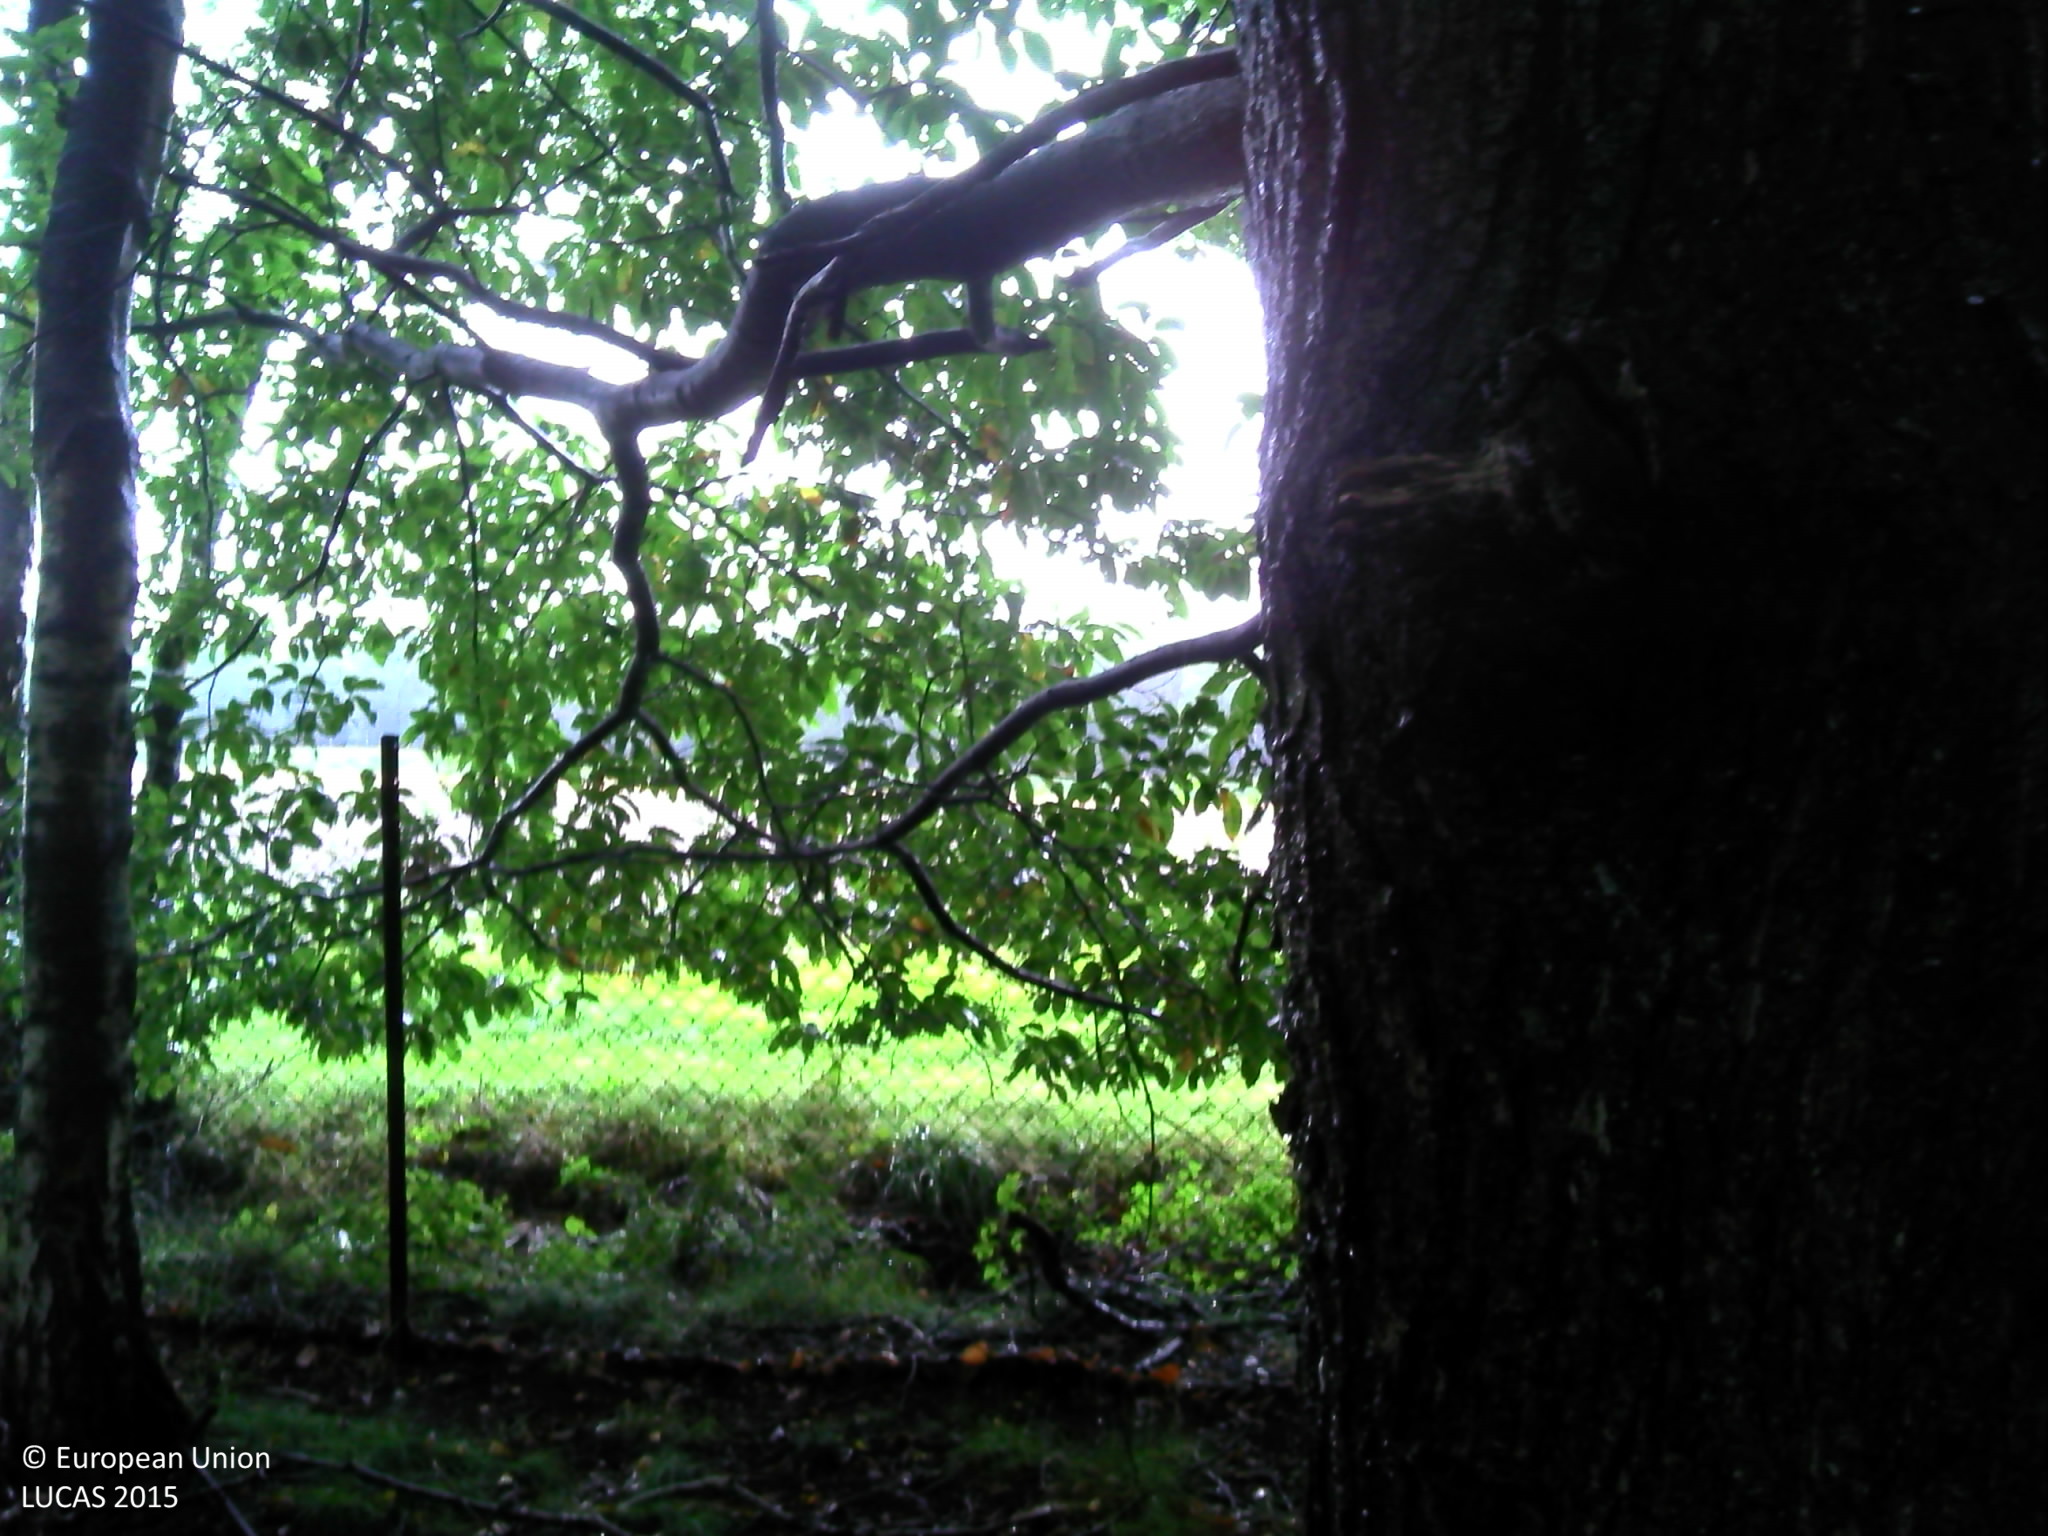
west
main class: Woodland
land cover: Broadleaved woodland
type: floodplain forest
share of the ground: > 75 %
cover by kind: broadleaved forest trees 80 %, herbaceous plants 20 %
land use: Forestry
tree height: > 5 m
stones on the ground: < 10 %
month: September
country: BE
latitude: 51.3416
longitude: 4.7279
